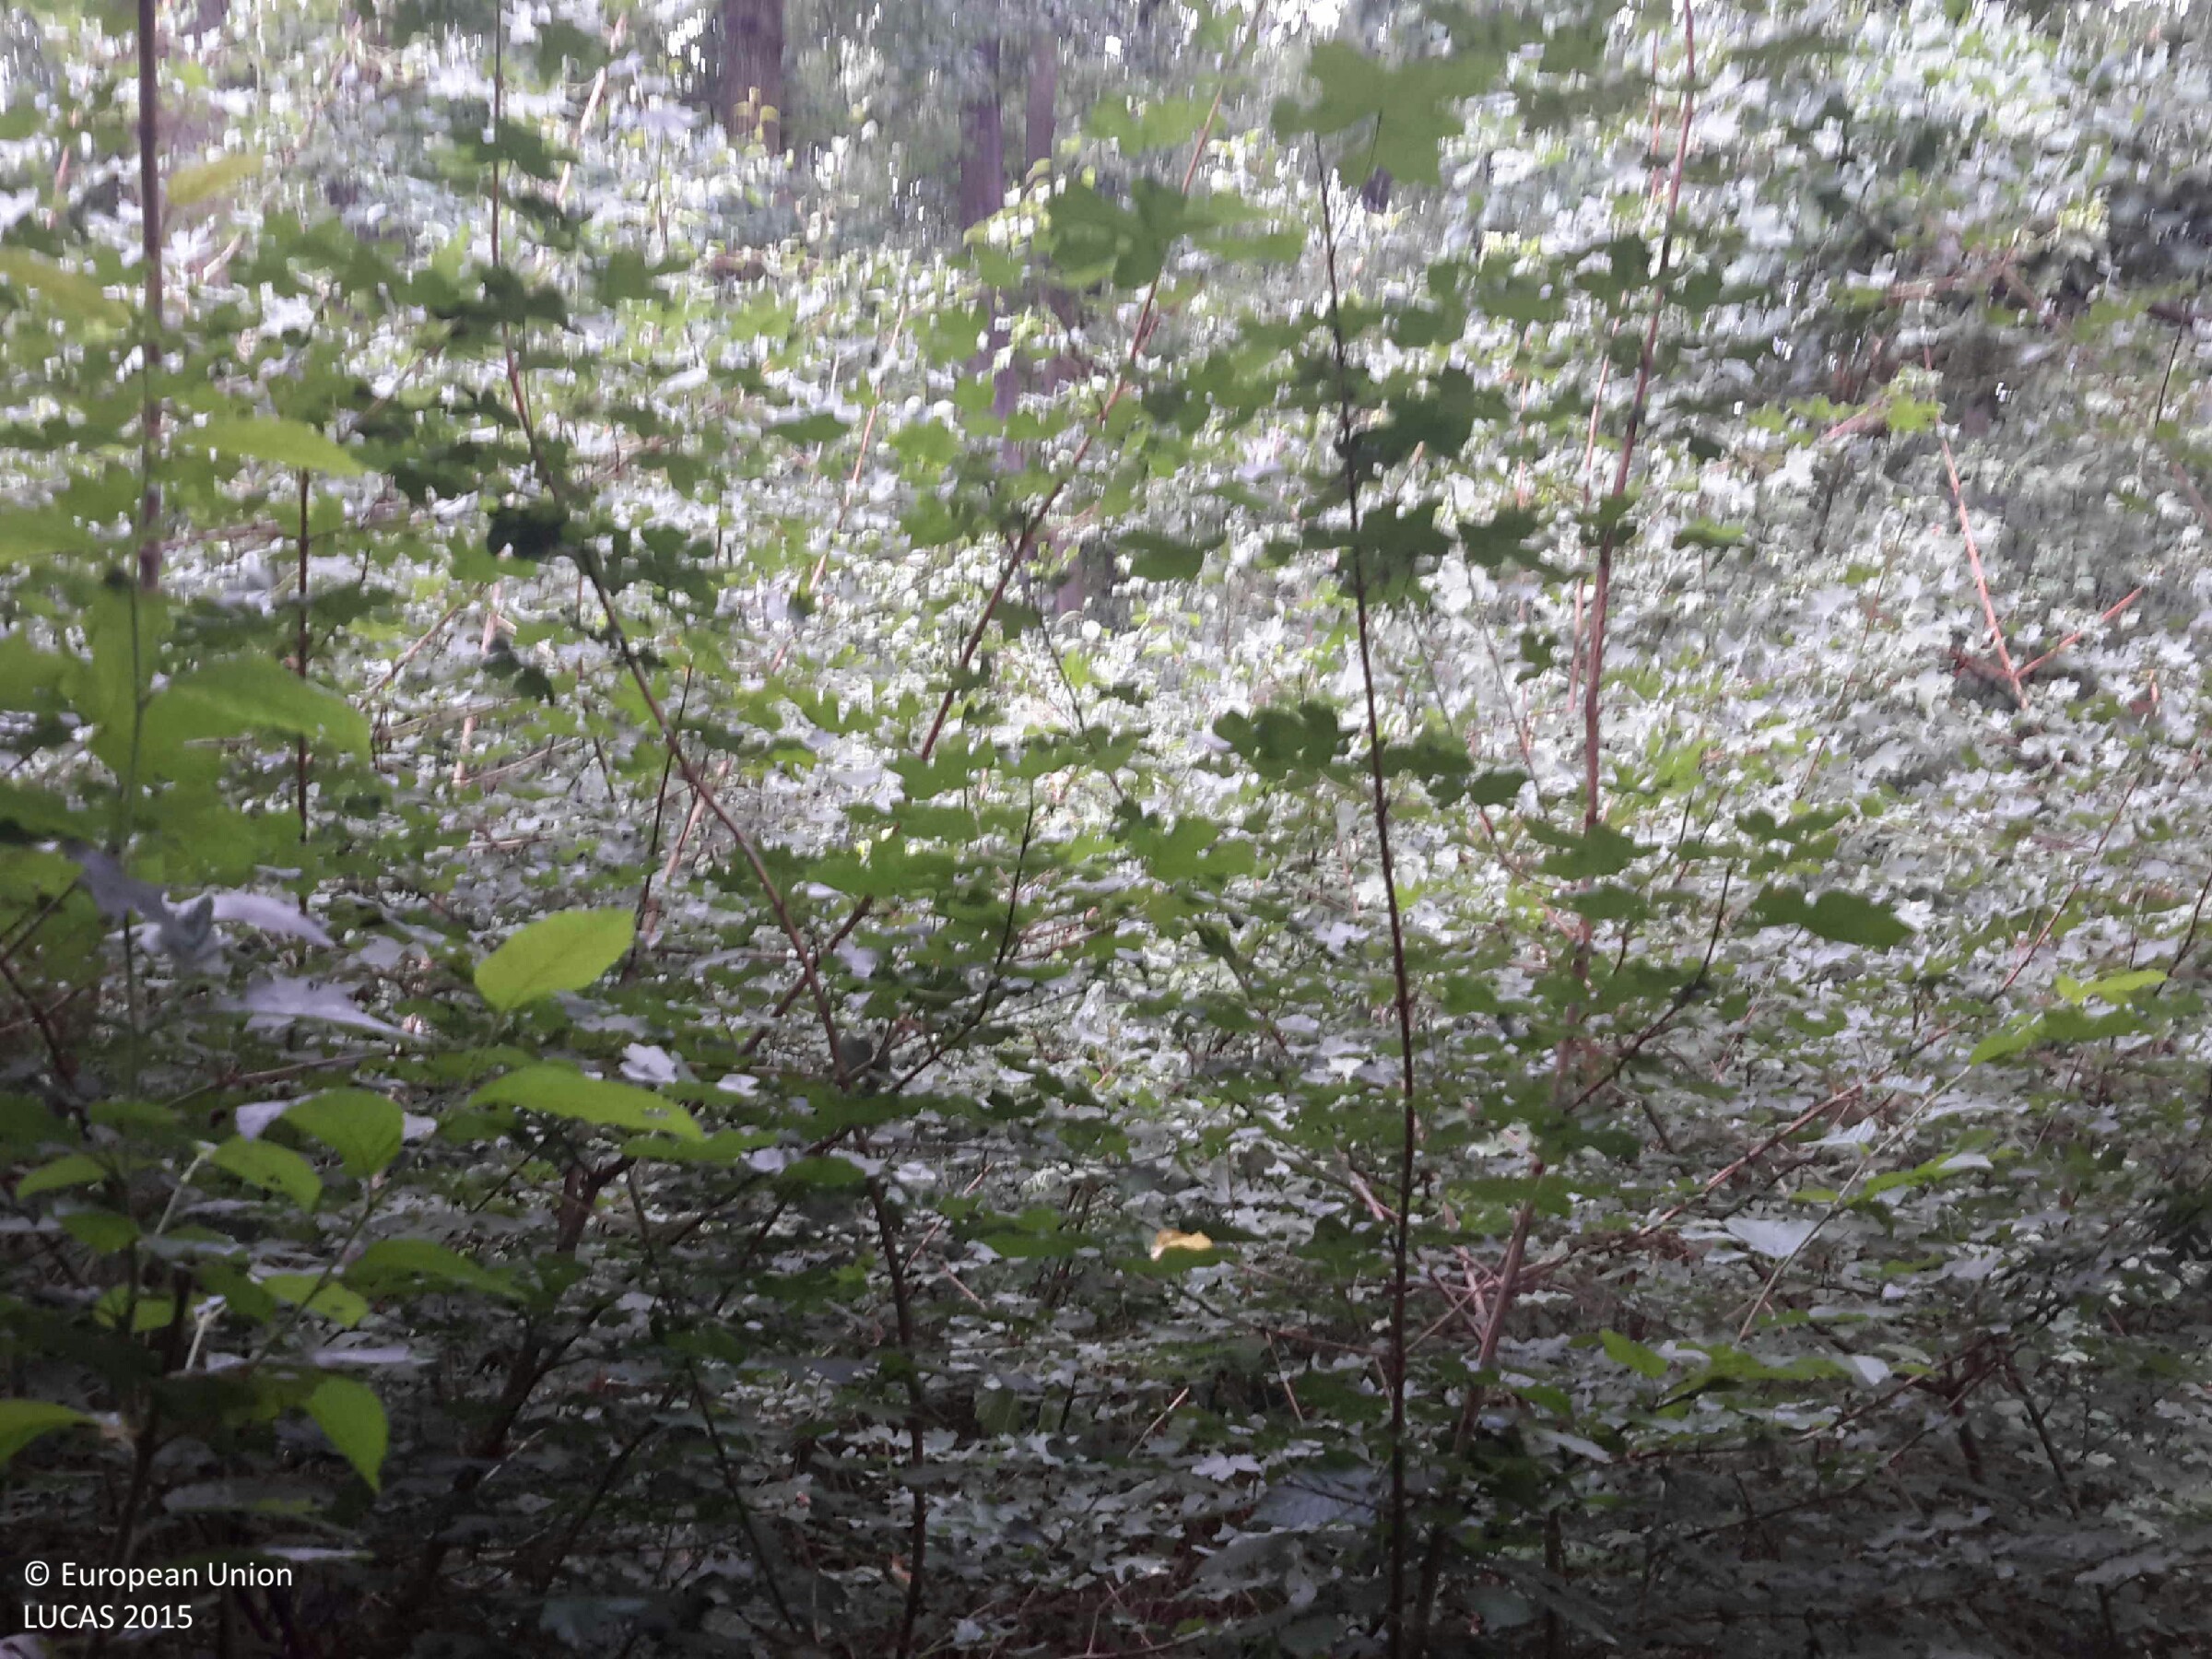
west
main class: Woodland
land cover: Broadleaved woodland
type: mesophytic deciduous forest
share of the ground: > 75 %
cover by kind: broadleaved forest trees 80 %, herbaceous plants 20 %
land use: Forestry
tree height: > 5 m
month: July
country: HU
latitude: 47.4241
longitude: 17.2578
